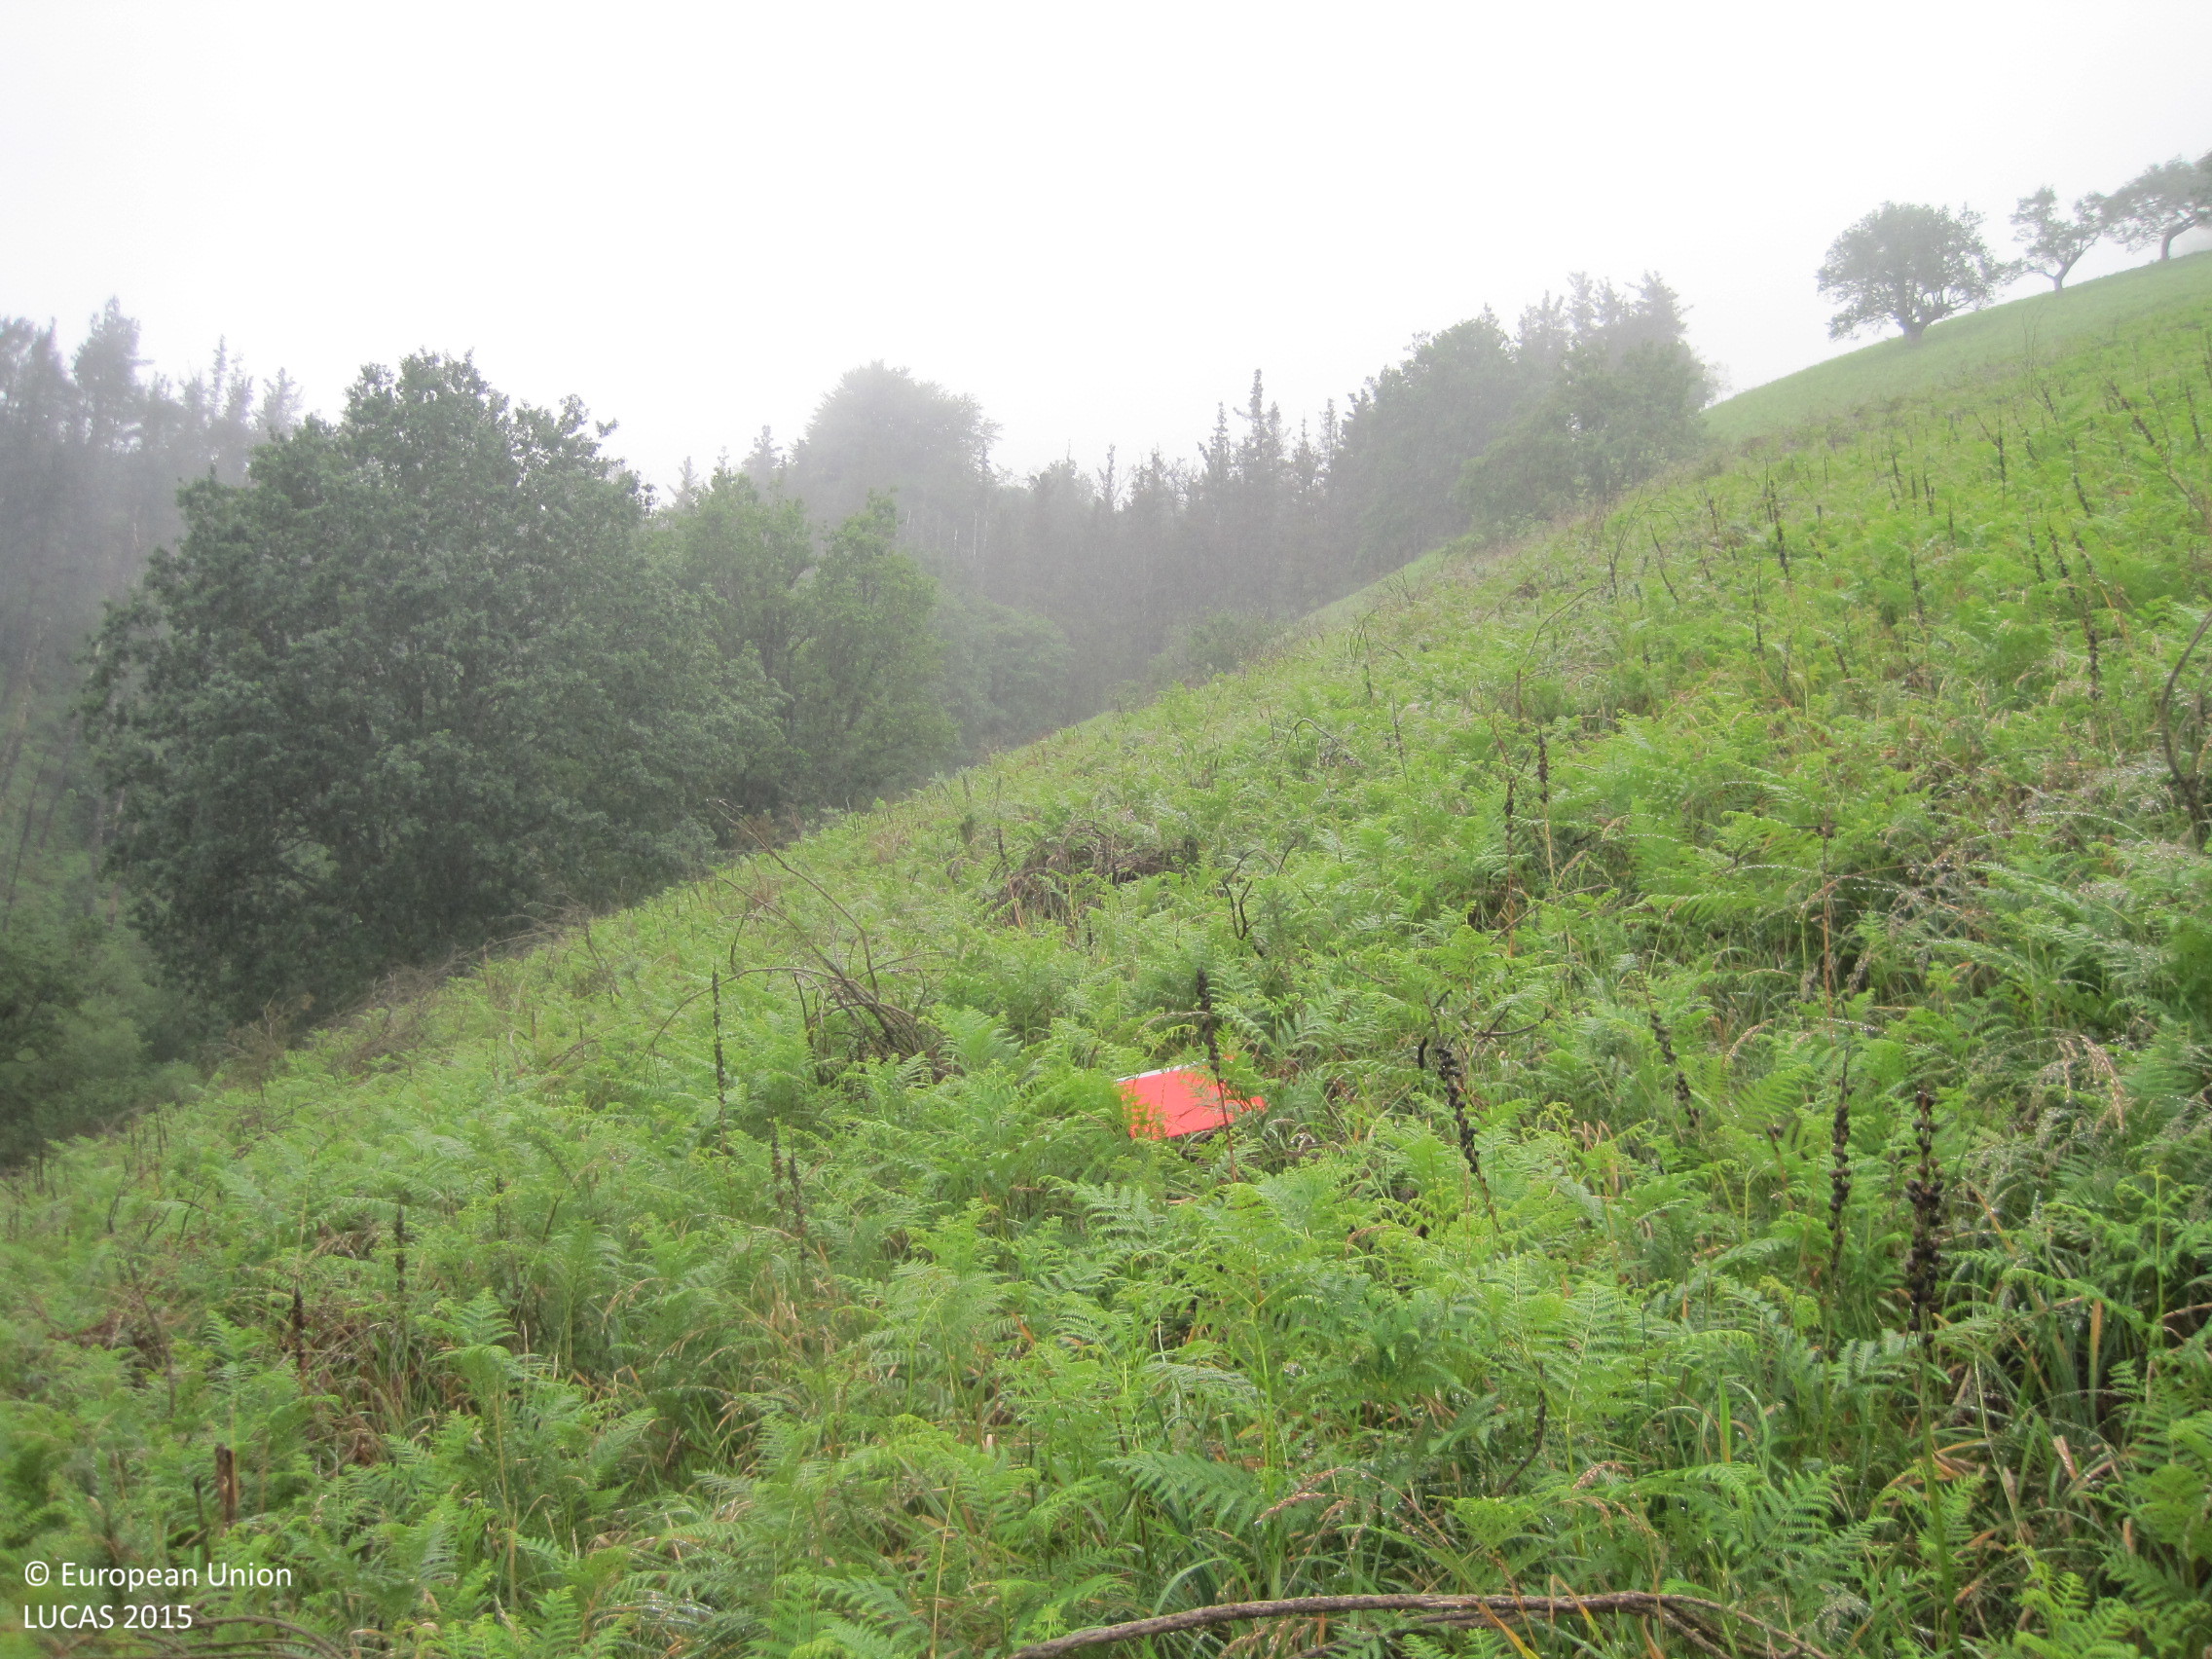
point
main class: Grassland
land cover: Grassland without tree/shrub cover
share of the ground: > 75 %
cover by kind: herbaceous plants 100 %
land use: Agriculture (excluding fallow land and kitchen gardens)
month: June
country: ES
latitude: 43.1958
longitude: -1.8459
